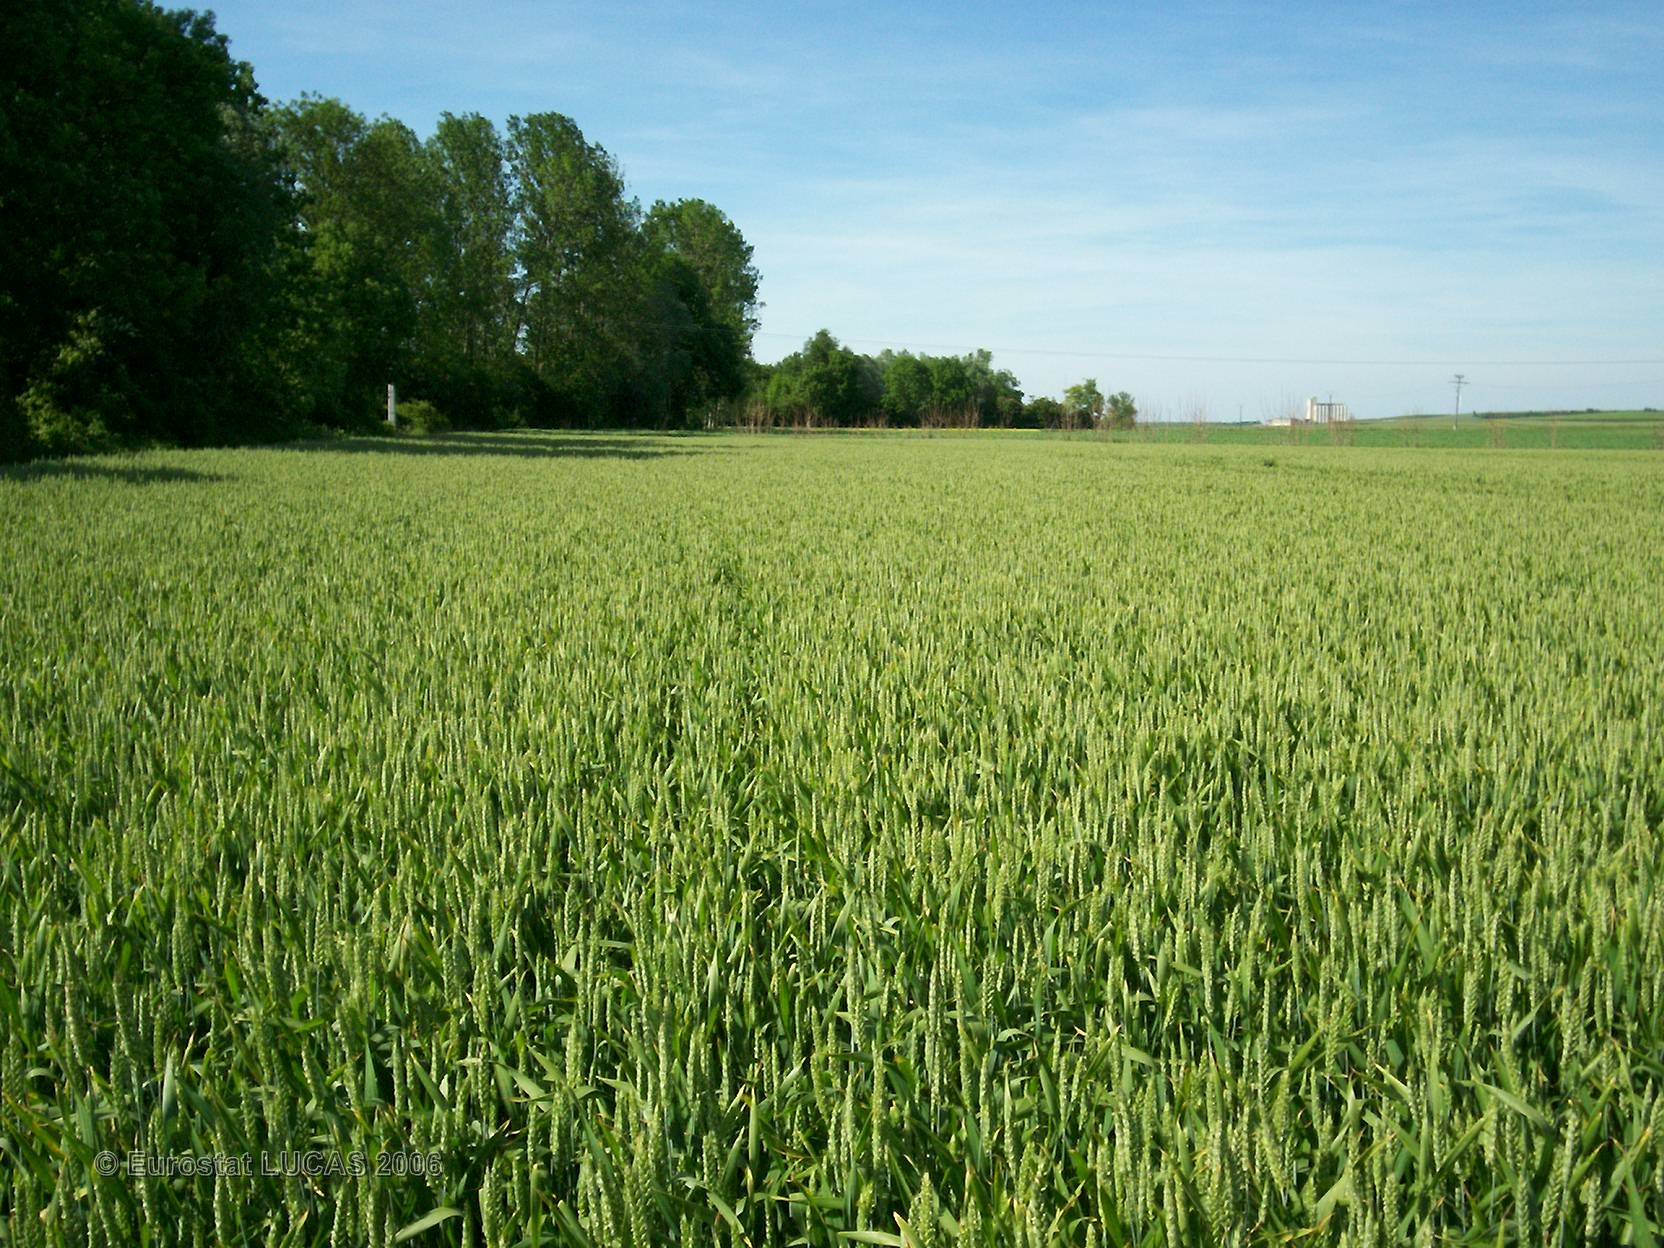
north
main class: Cropland
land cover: Common wheat
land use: Agriculture (excluding fallow land and kitchen gardens)
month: June
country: FR
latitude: 48.9839
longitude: 4.7913
